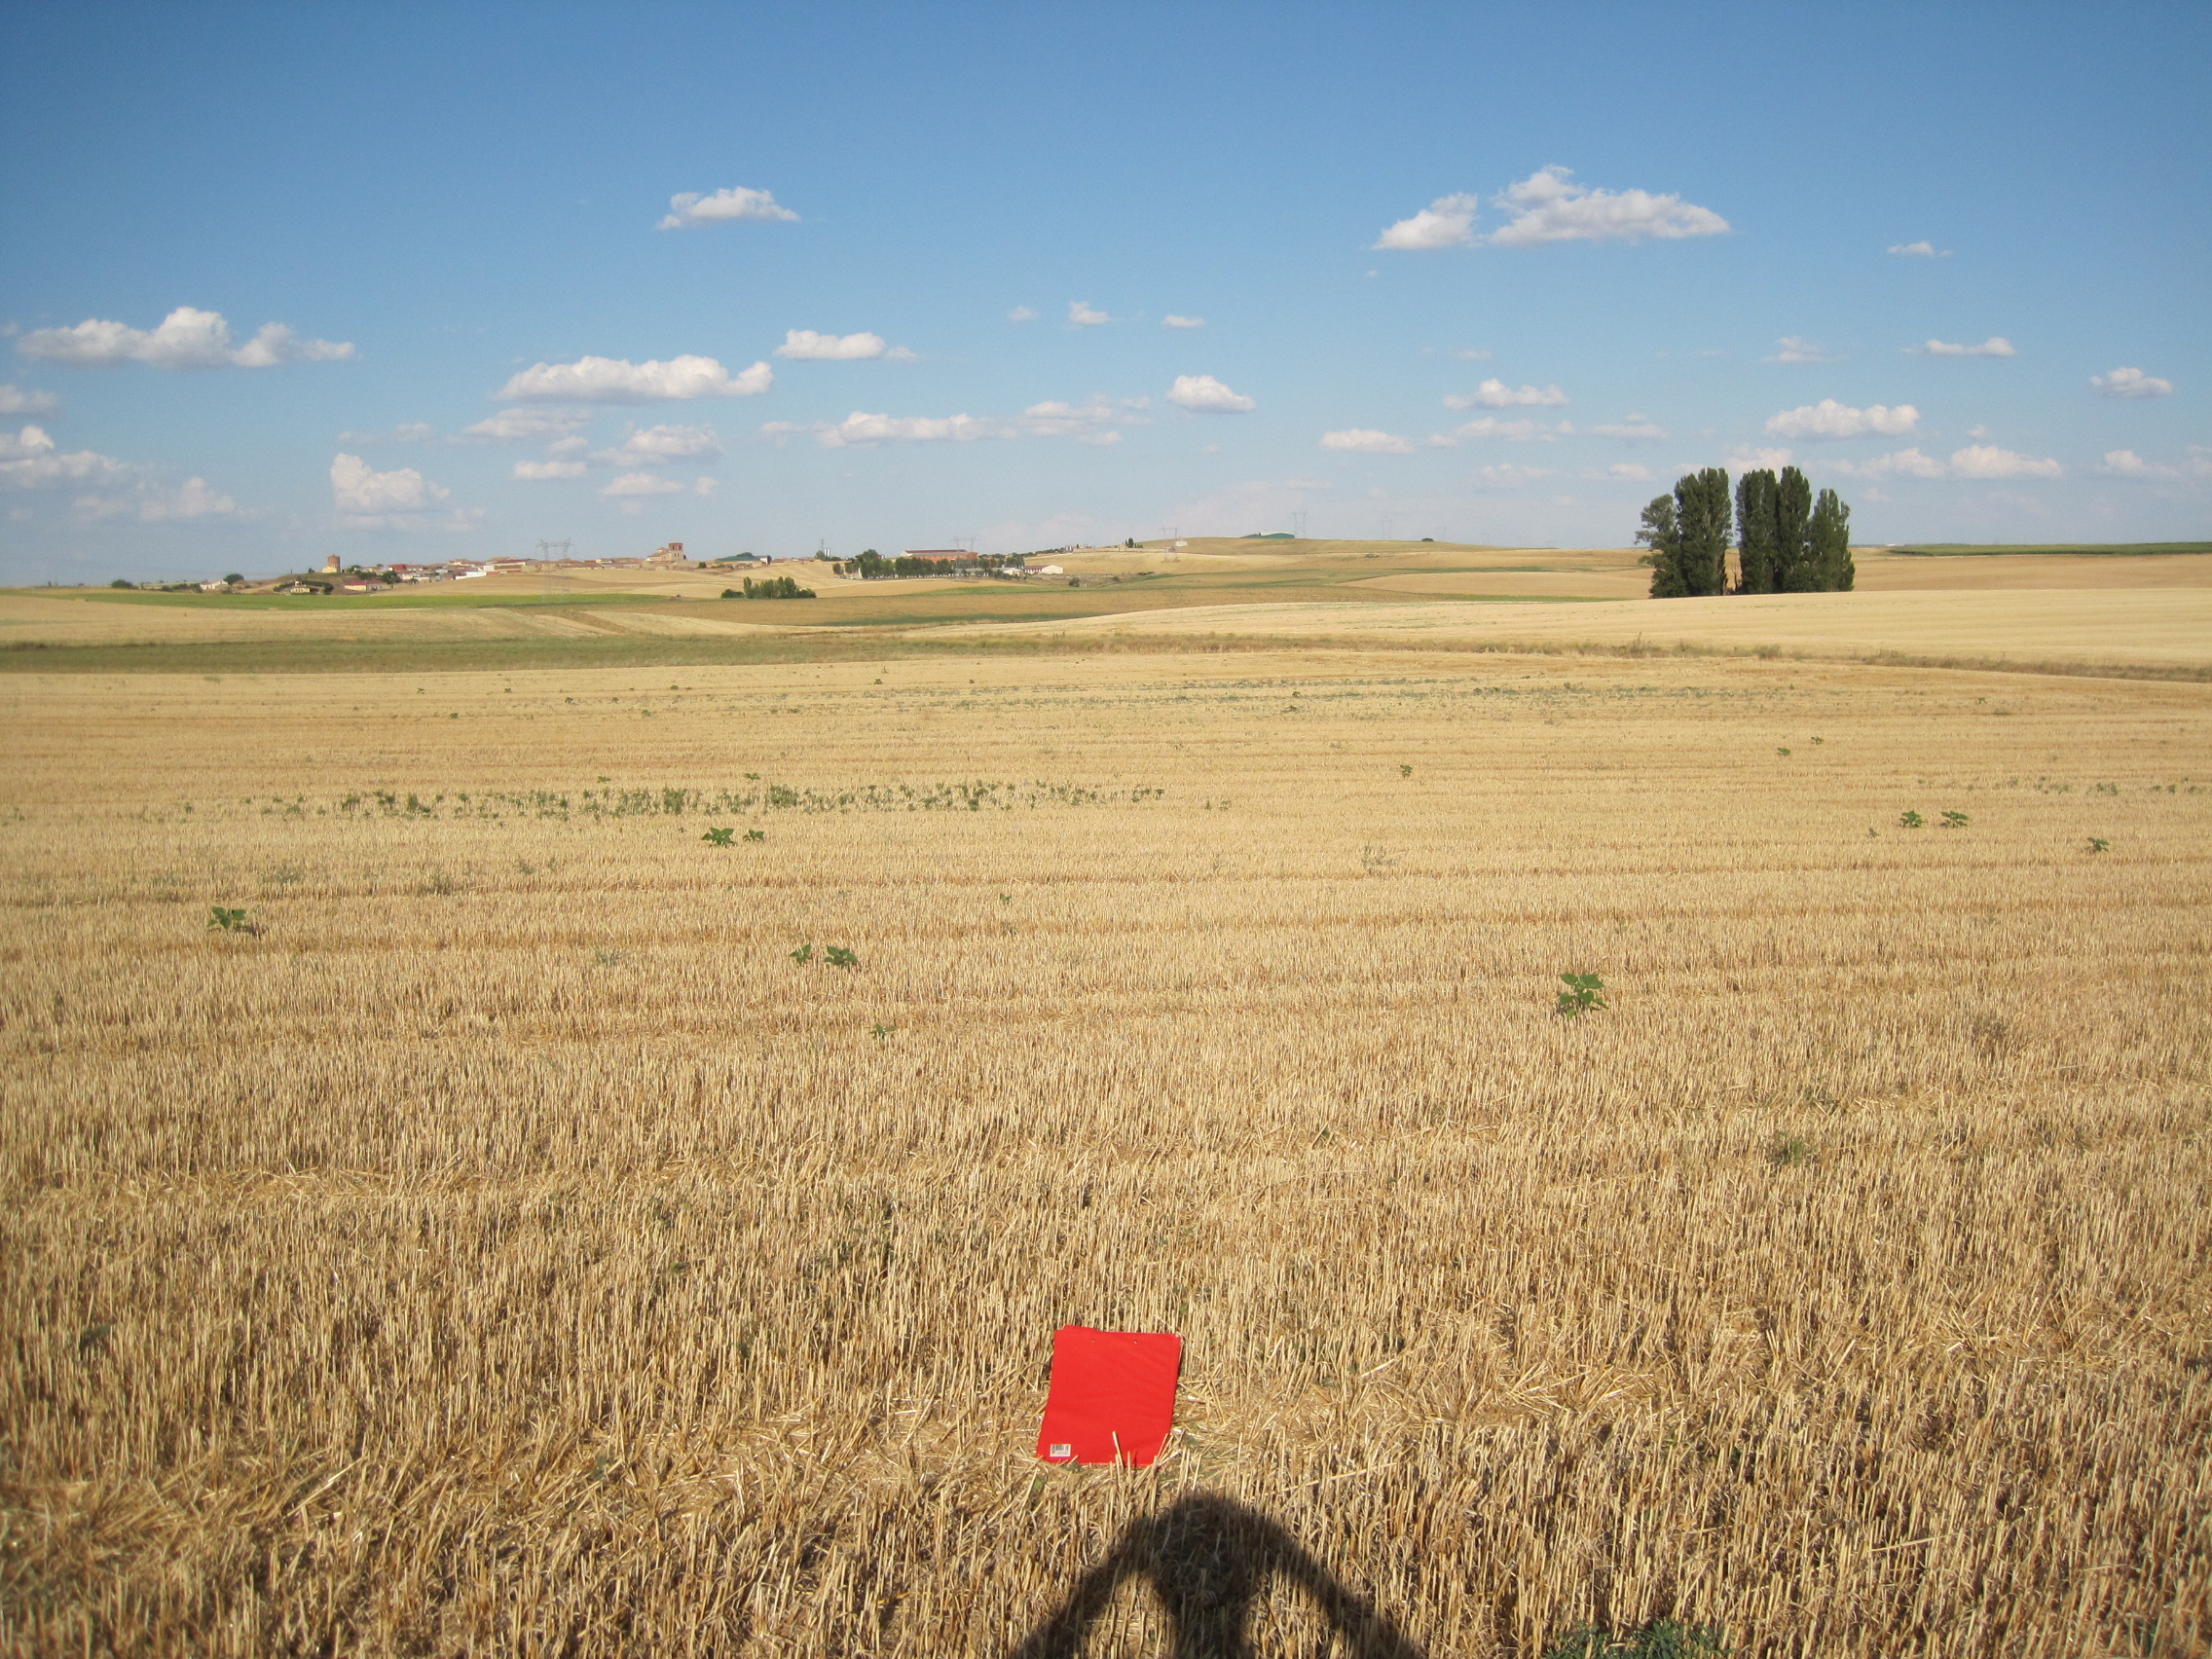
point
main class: Cropland
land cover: Barley
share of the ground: < 10 %
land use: Agriculture (excluding fallow land and kitchen gardens)
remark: Harvested field
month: July
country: ES
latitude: 41.9262
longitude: -5.1663
